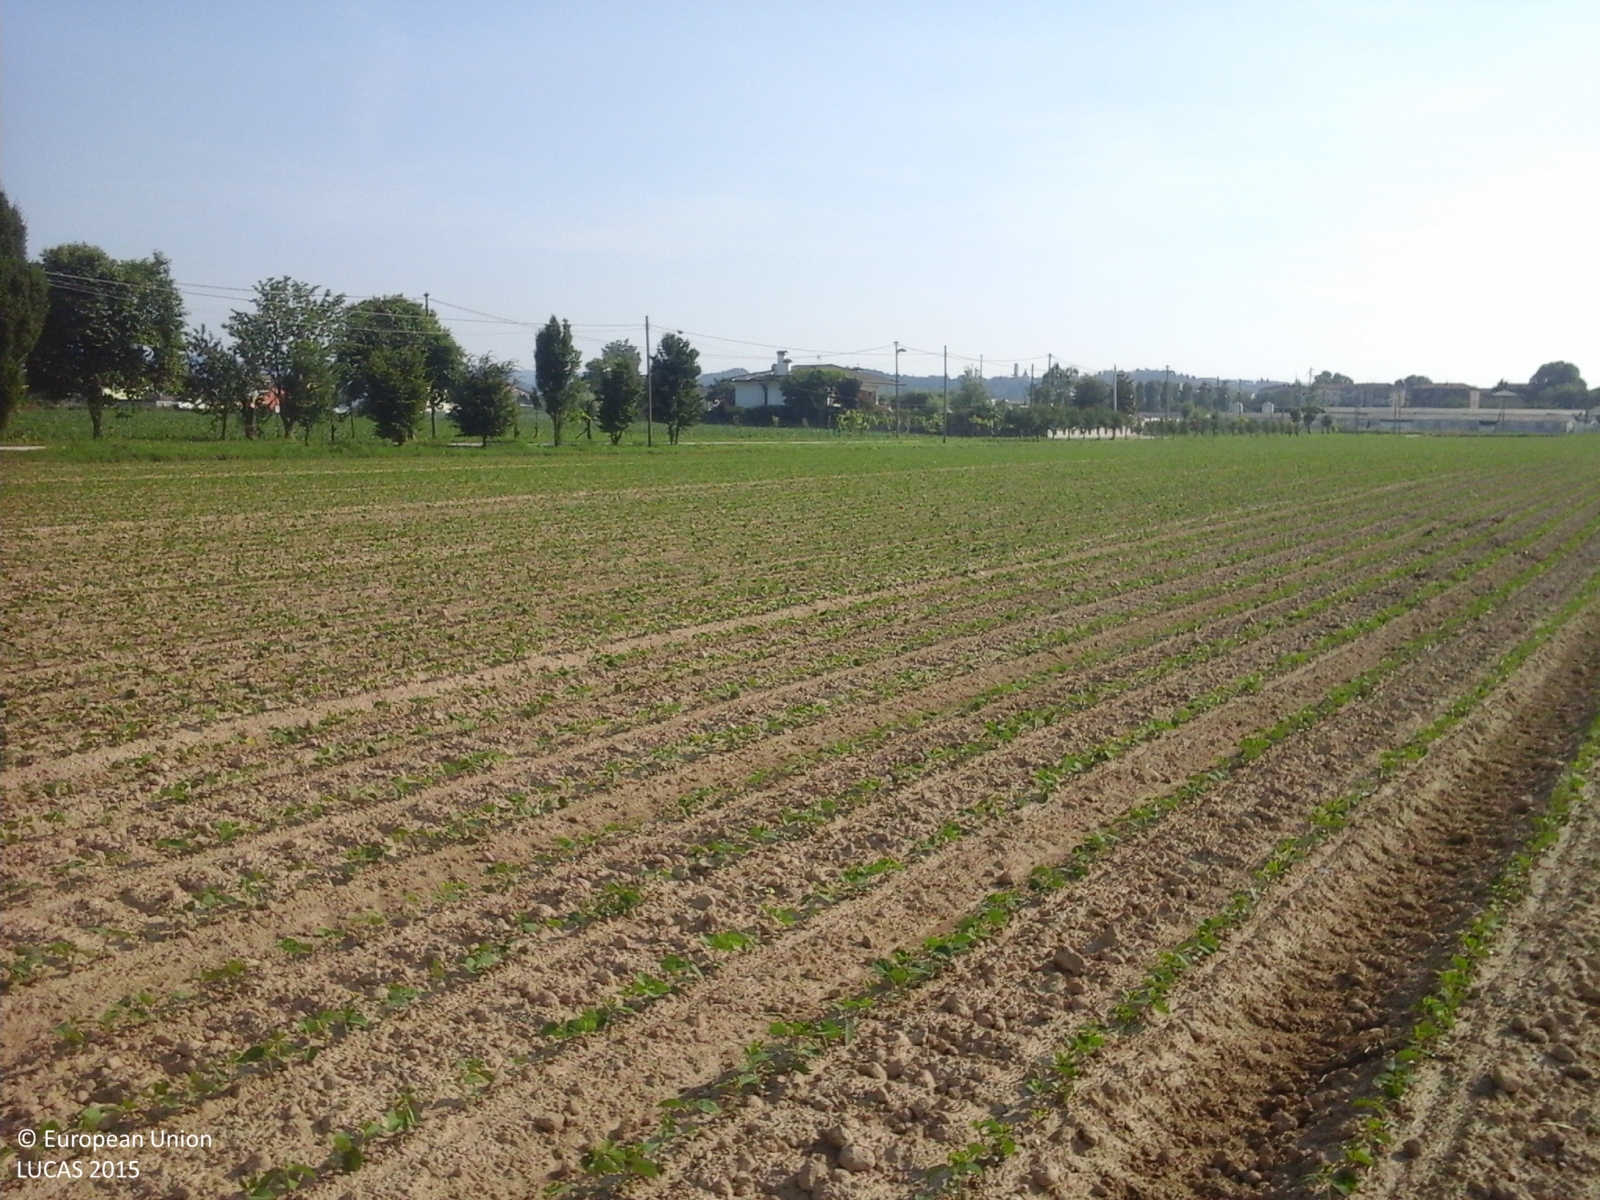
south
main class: Cropland
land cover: Soya
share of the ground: < 10 %
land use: Agriculture (excluding fallow land and kitchen gardens)
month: May
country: IT
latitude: 45.5648
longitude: 11.5734
